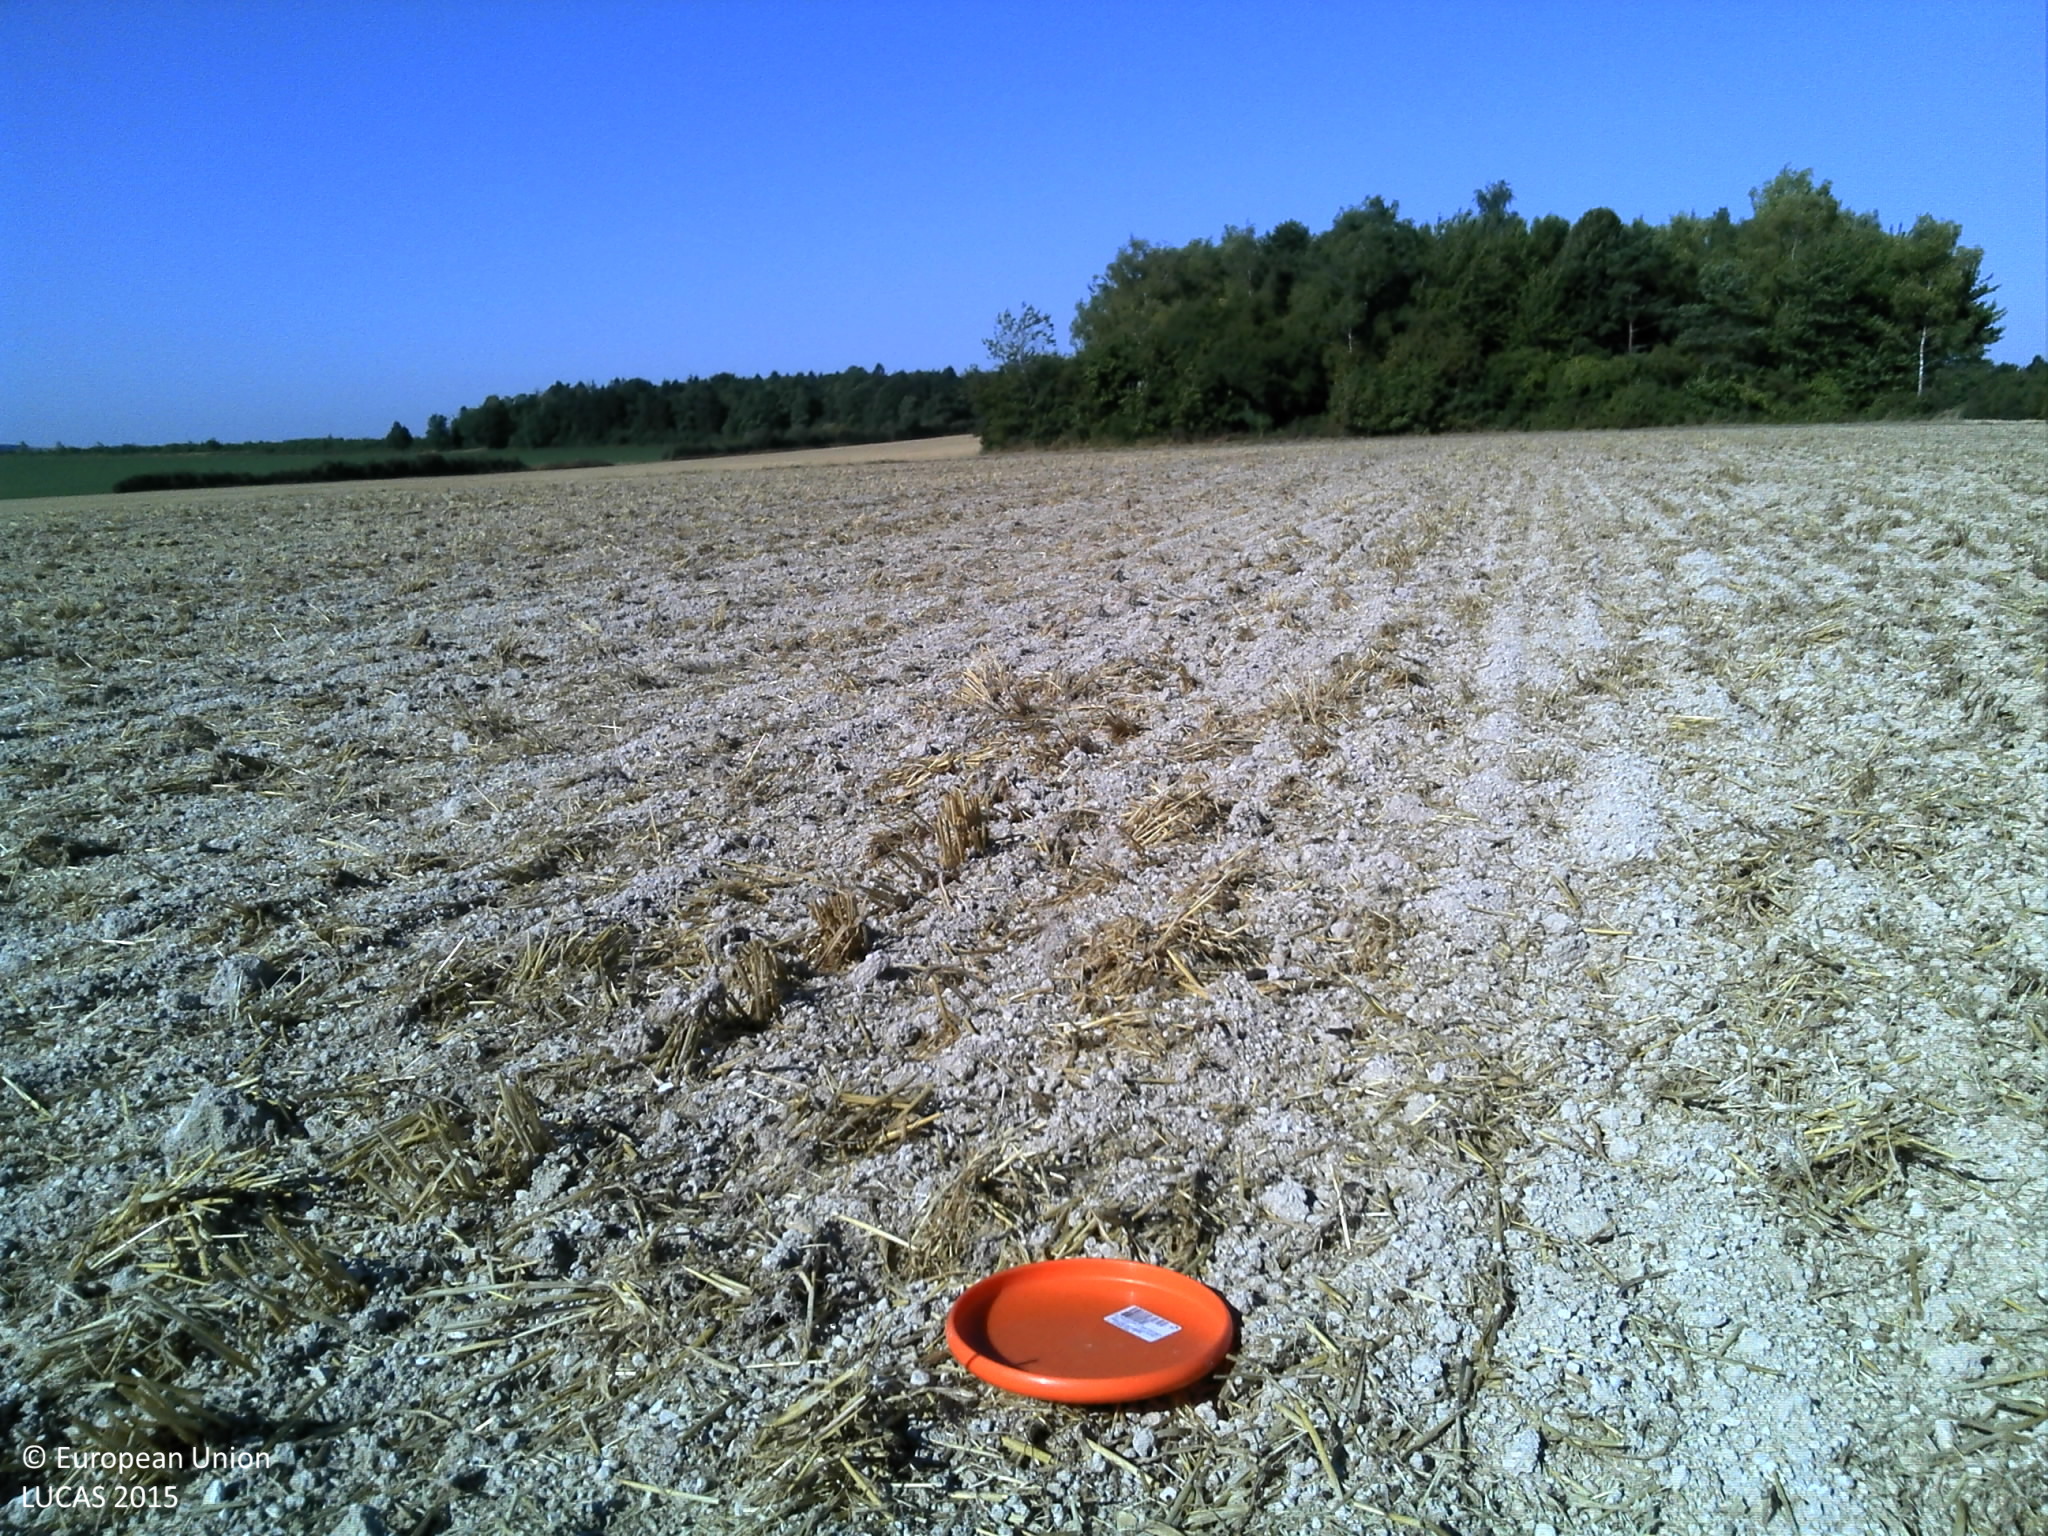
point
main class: Cropland
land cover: Common wheat
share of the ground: > 75 %
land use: Agriculture (excluding fallow land and kitchen gardens)
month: August
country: FR
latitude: 49.0710
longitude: 4.7272
